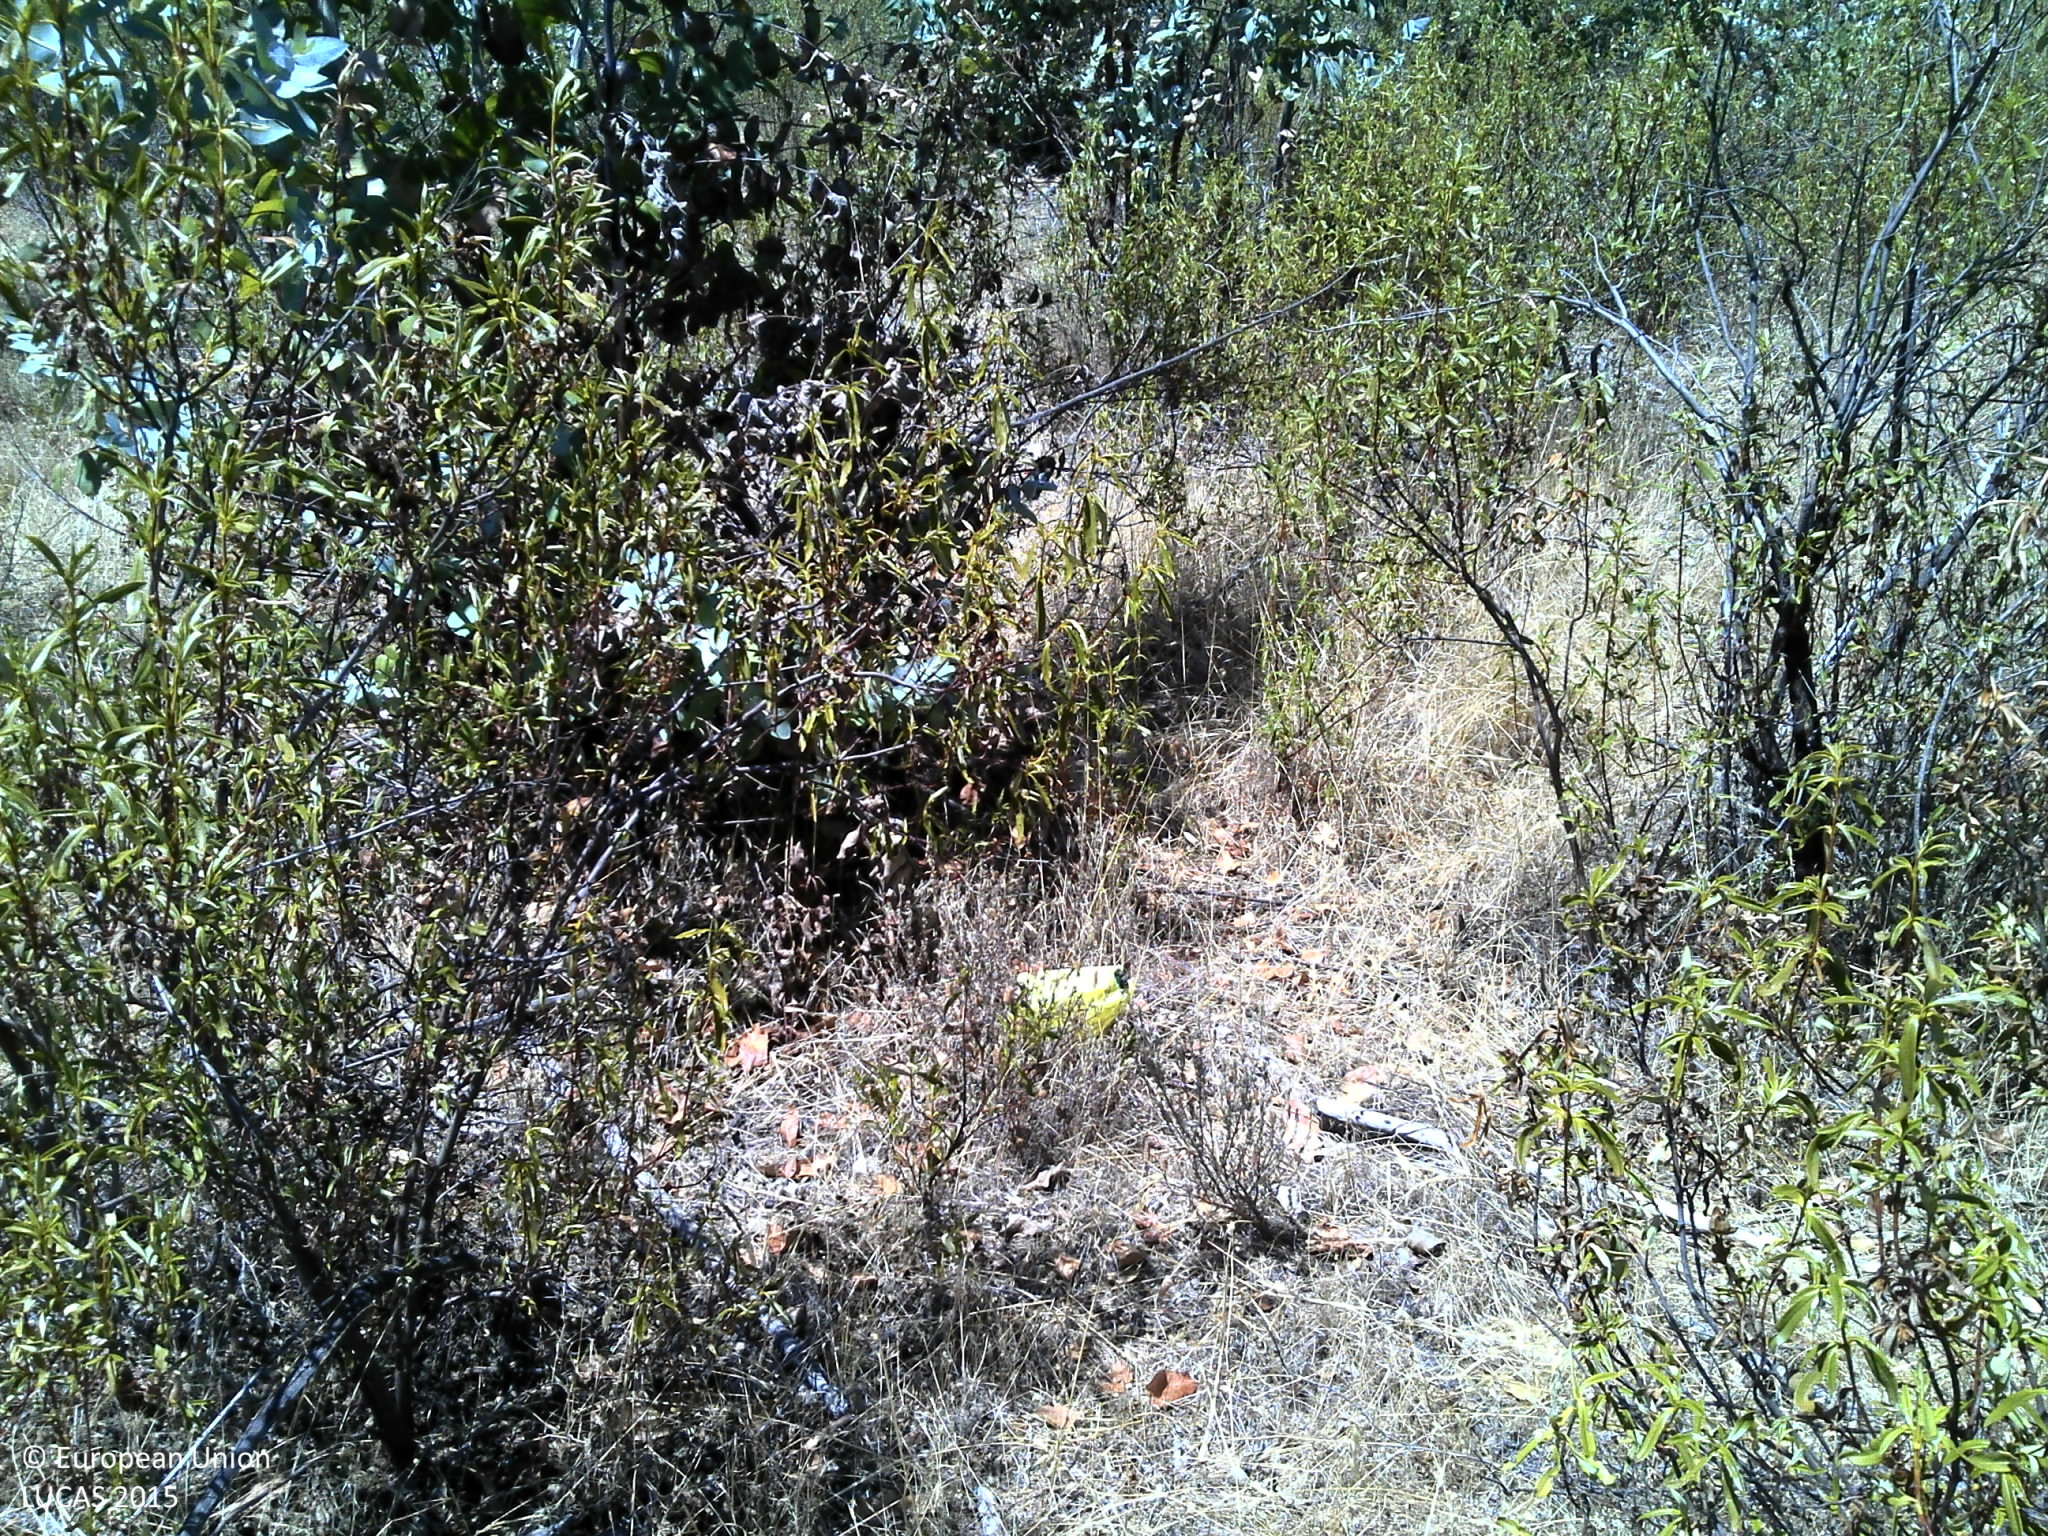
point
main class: Woodland
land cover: Broadleaved woodland
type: exotic forest
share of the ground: 10 - 25 %
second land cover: Shrubland without tree cover
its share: > 75 %
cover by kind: shrubs 90 %, broadleaved forest trees 10 %
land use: Forestry
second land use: Agriculture (excluding fallow land and kitchen gardens)
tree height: > 5 m
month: August
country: PT
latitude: 39.5364
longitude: -7.4642
